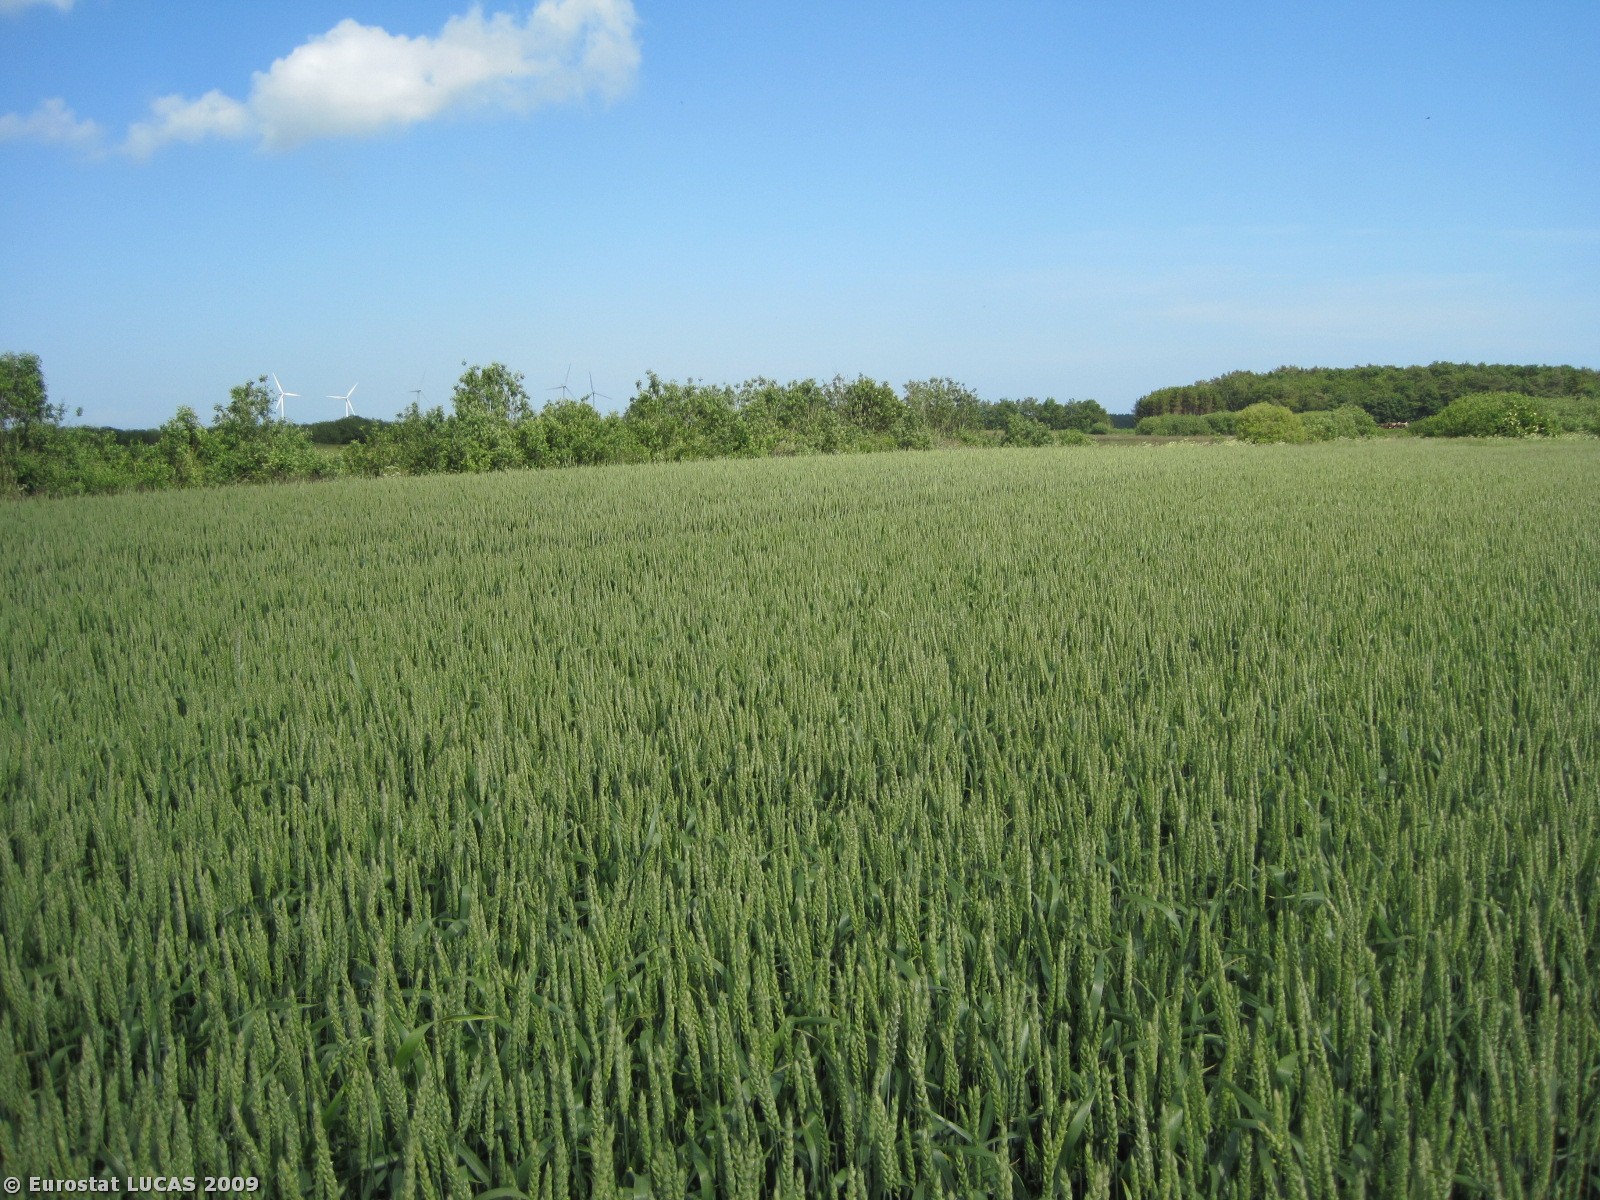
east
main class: Cropland
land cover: Common wheat
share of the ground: > 75 %
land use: Agriculture (excluding fallow land and kitchen gardens)
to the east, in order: Common wheat; Grass margins; Shrubland without tree cover; Ditches and canals; Abandoned hedges; Fences; Grassland without tree/shrub cover
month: June
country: DK
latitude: 57.1224
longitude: 10.1814
